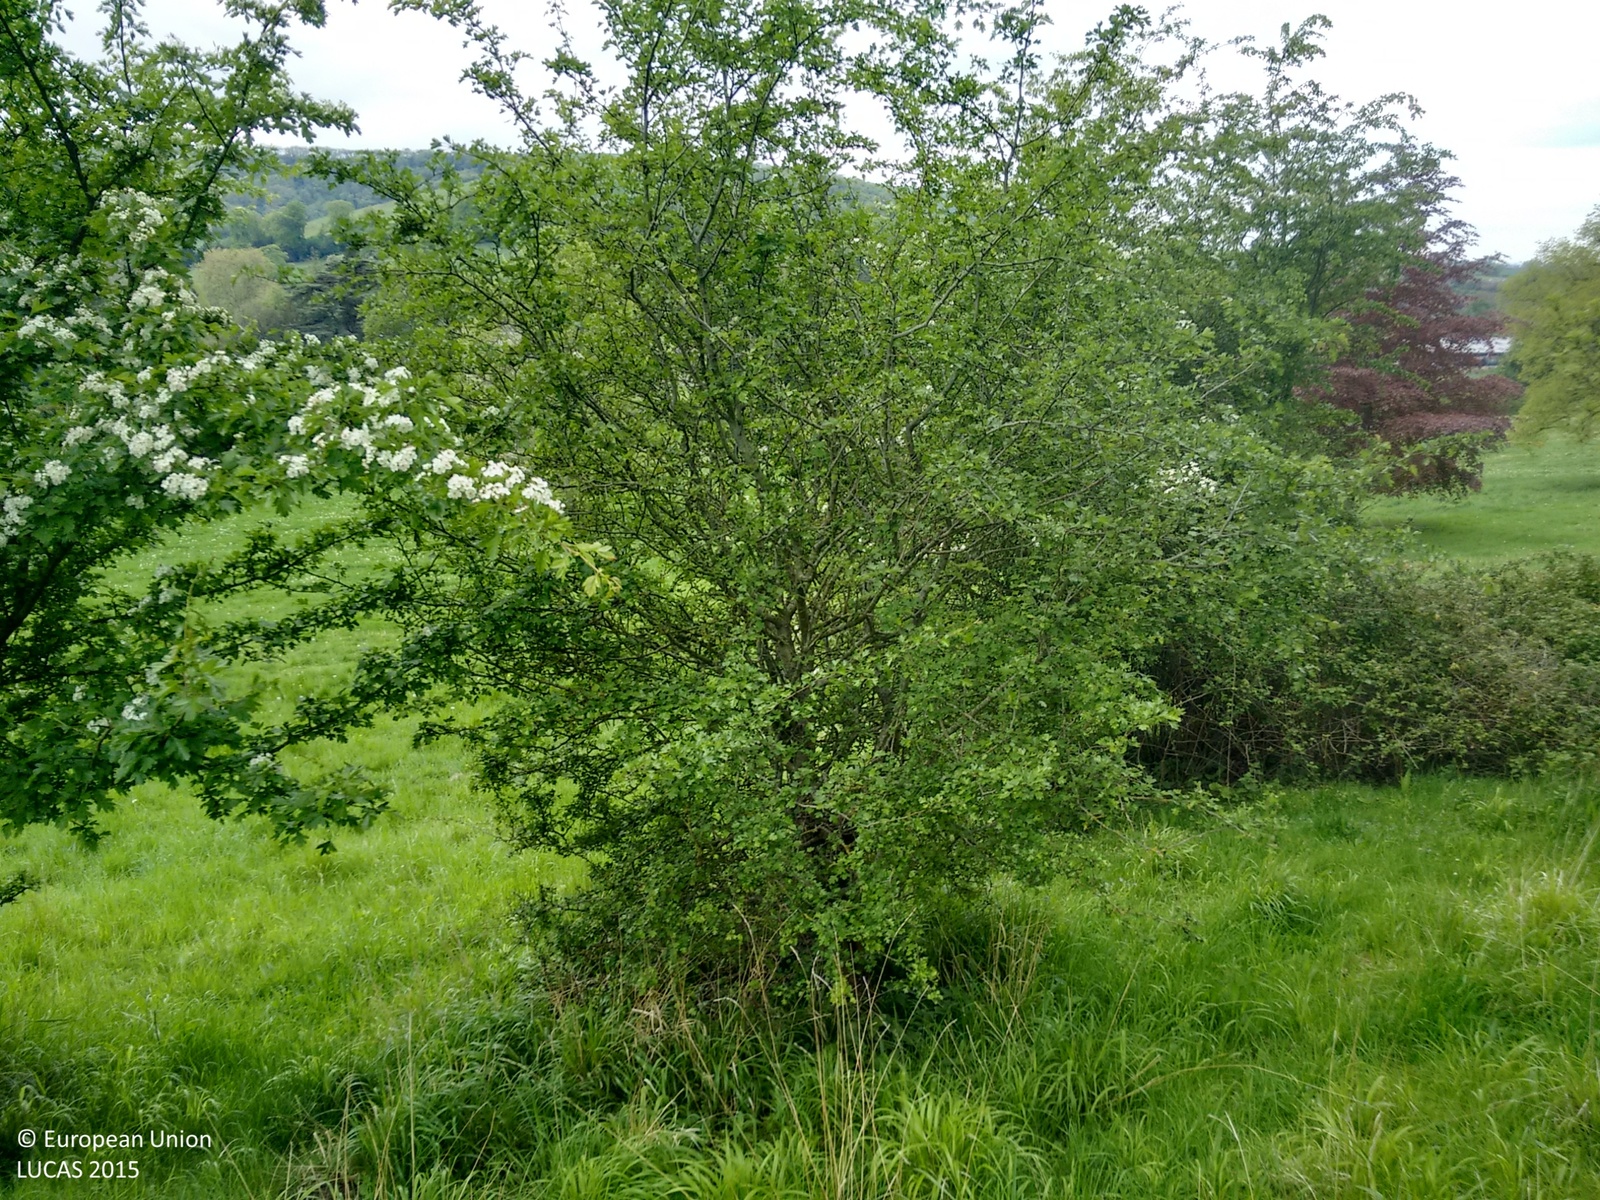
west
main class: Woodland
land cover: Broadleaved woodland
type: acidophilous oak and oak-birch forest
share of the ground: 50 - 75 %
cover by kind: broadleaved forest trees 50 %, herbaceous plants 45 %, shrubs 5 %
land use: Semi-natural and natural areas not in use
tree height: > 5 m
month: May
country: GB
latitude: 50.9094
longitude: -2.1926
